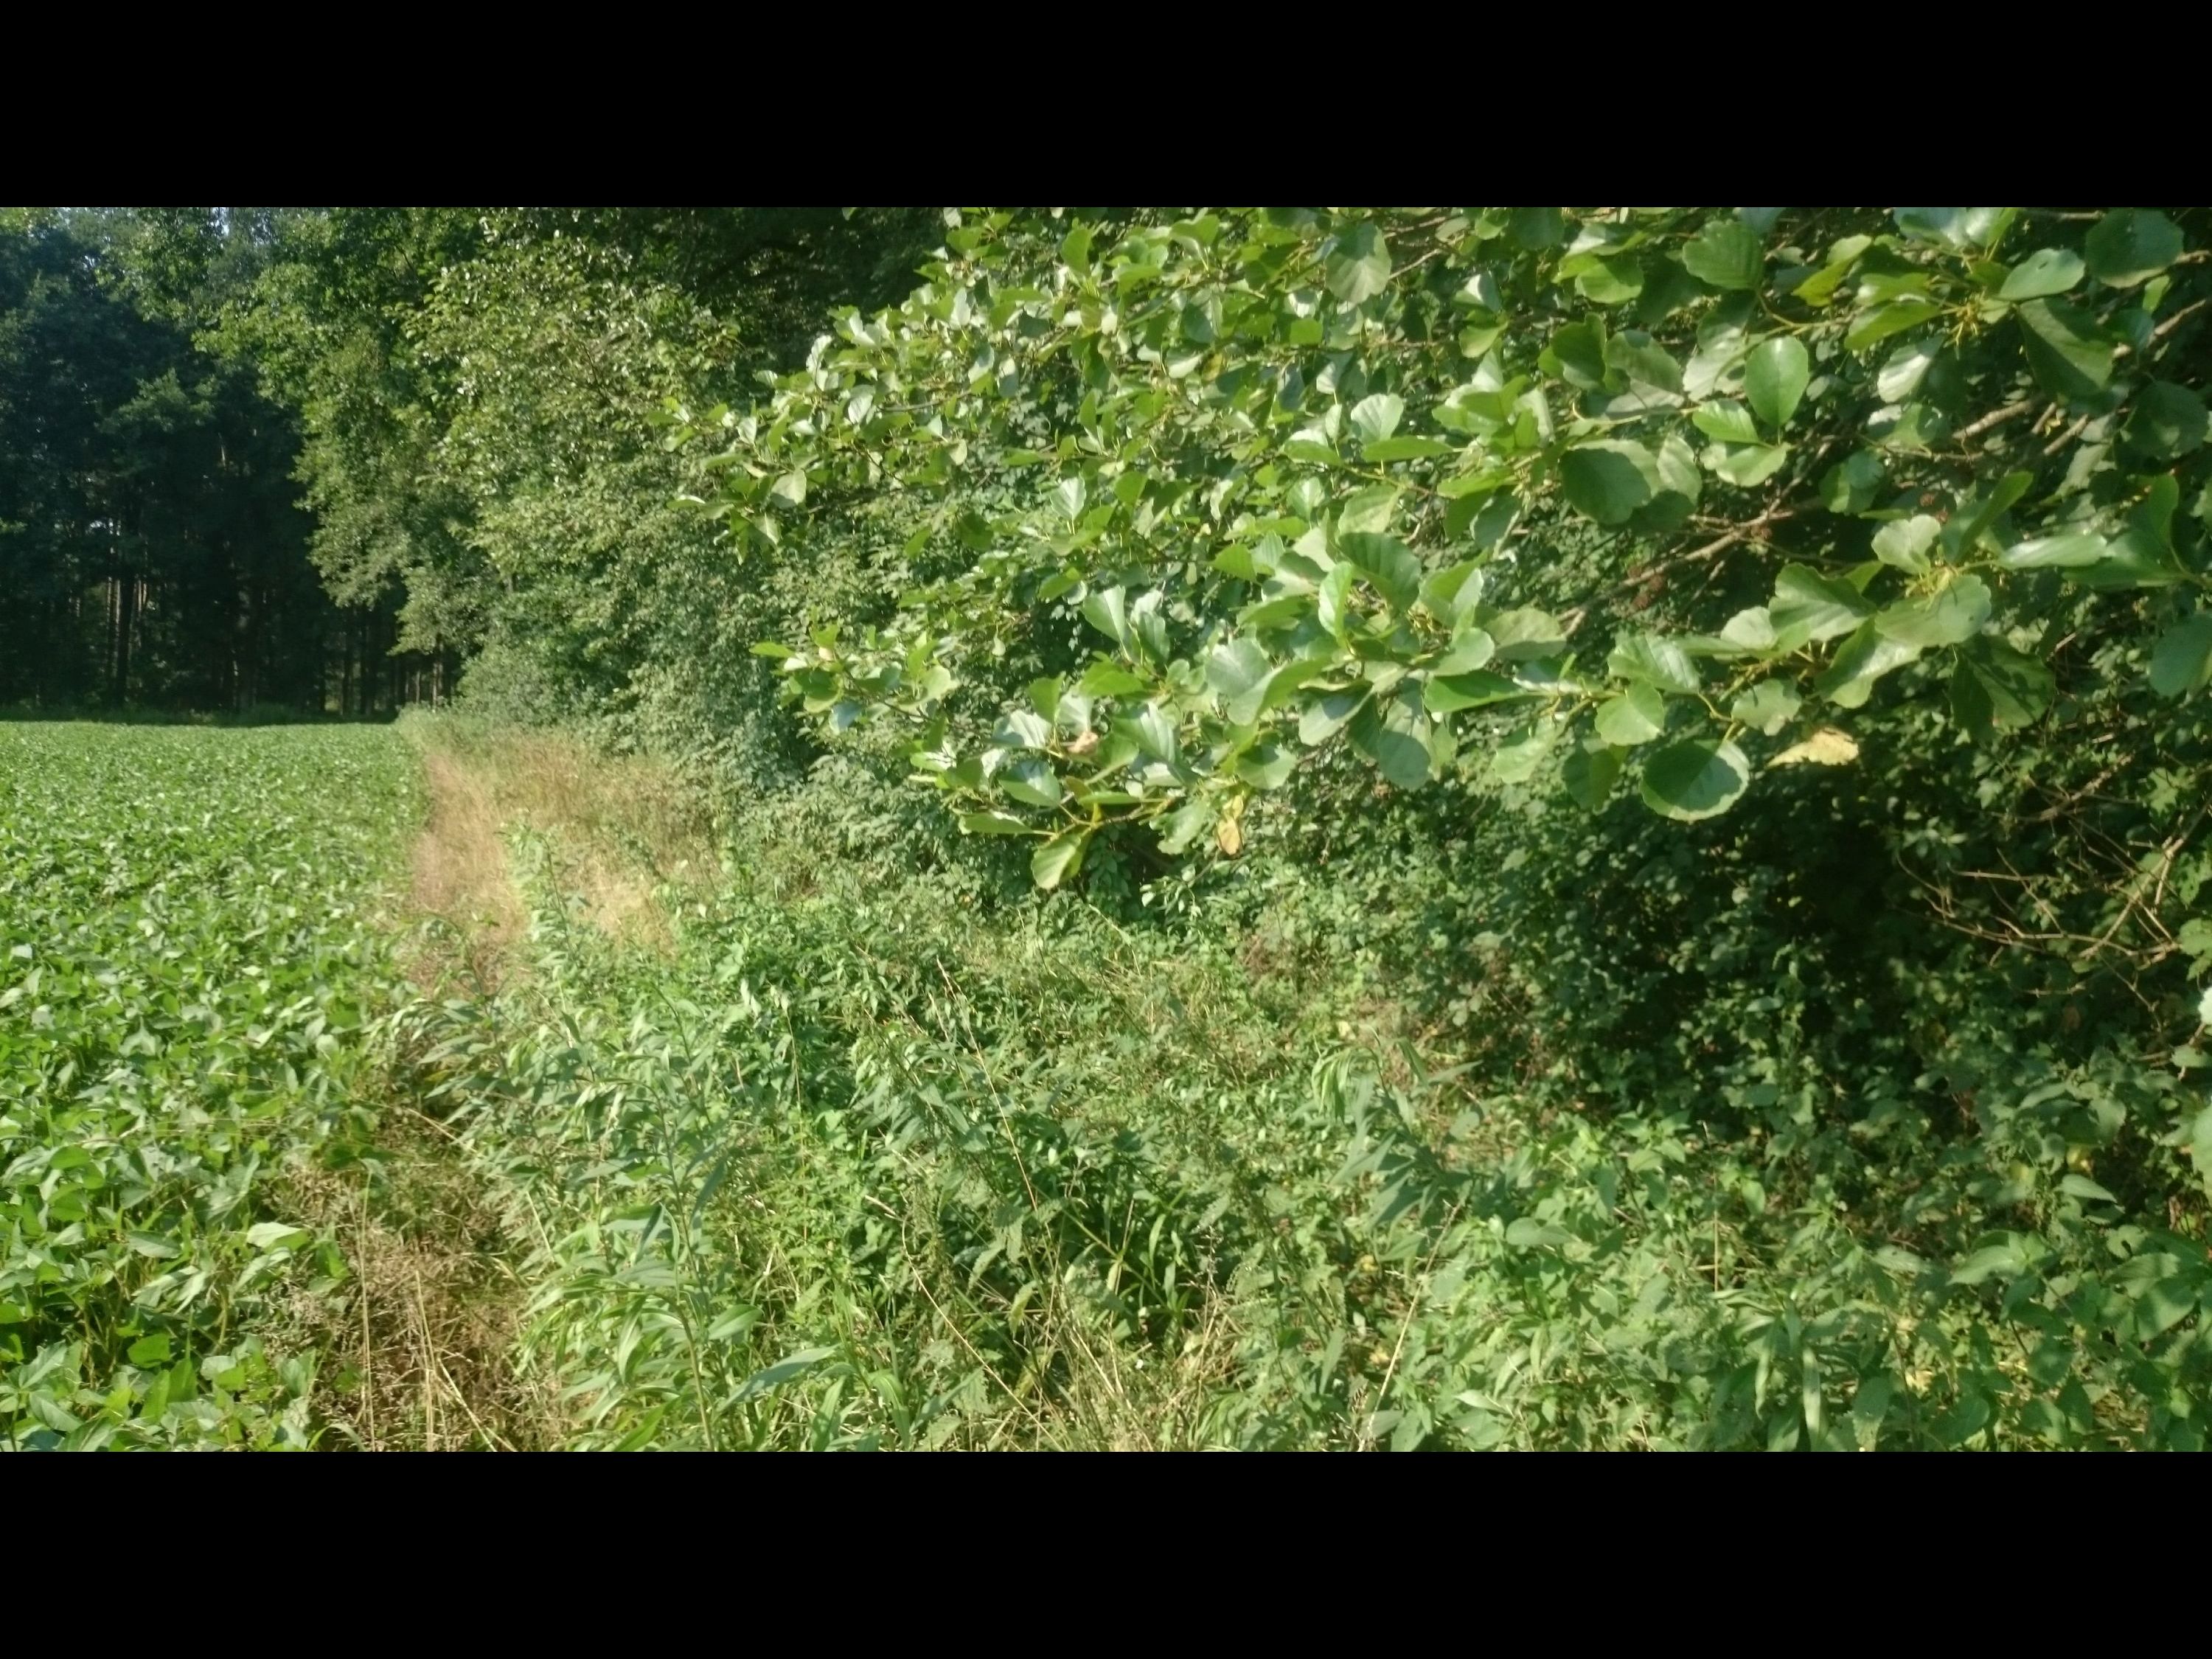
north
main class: Cropland
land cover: Soya
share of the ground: > 75 %
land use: Agriculture (excluding fallow land and kitchen gardens)
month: July
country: AT
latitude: 47.0514
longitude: 15.9642
